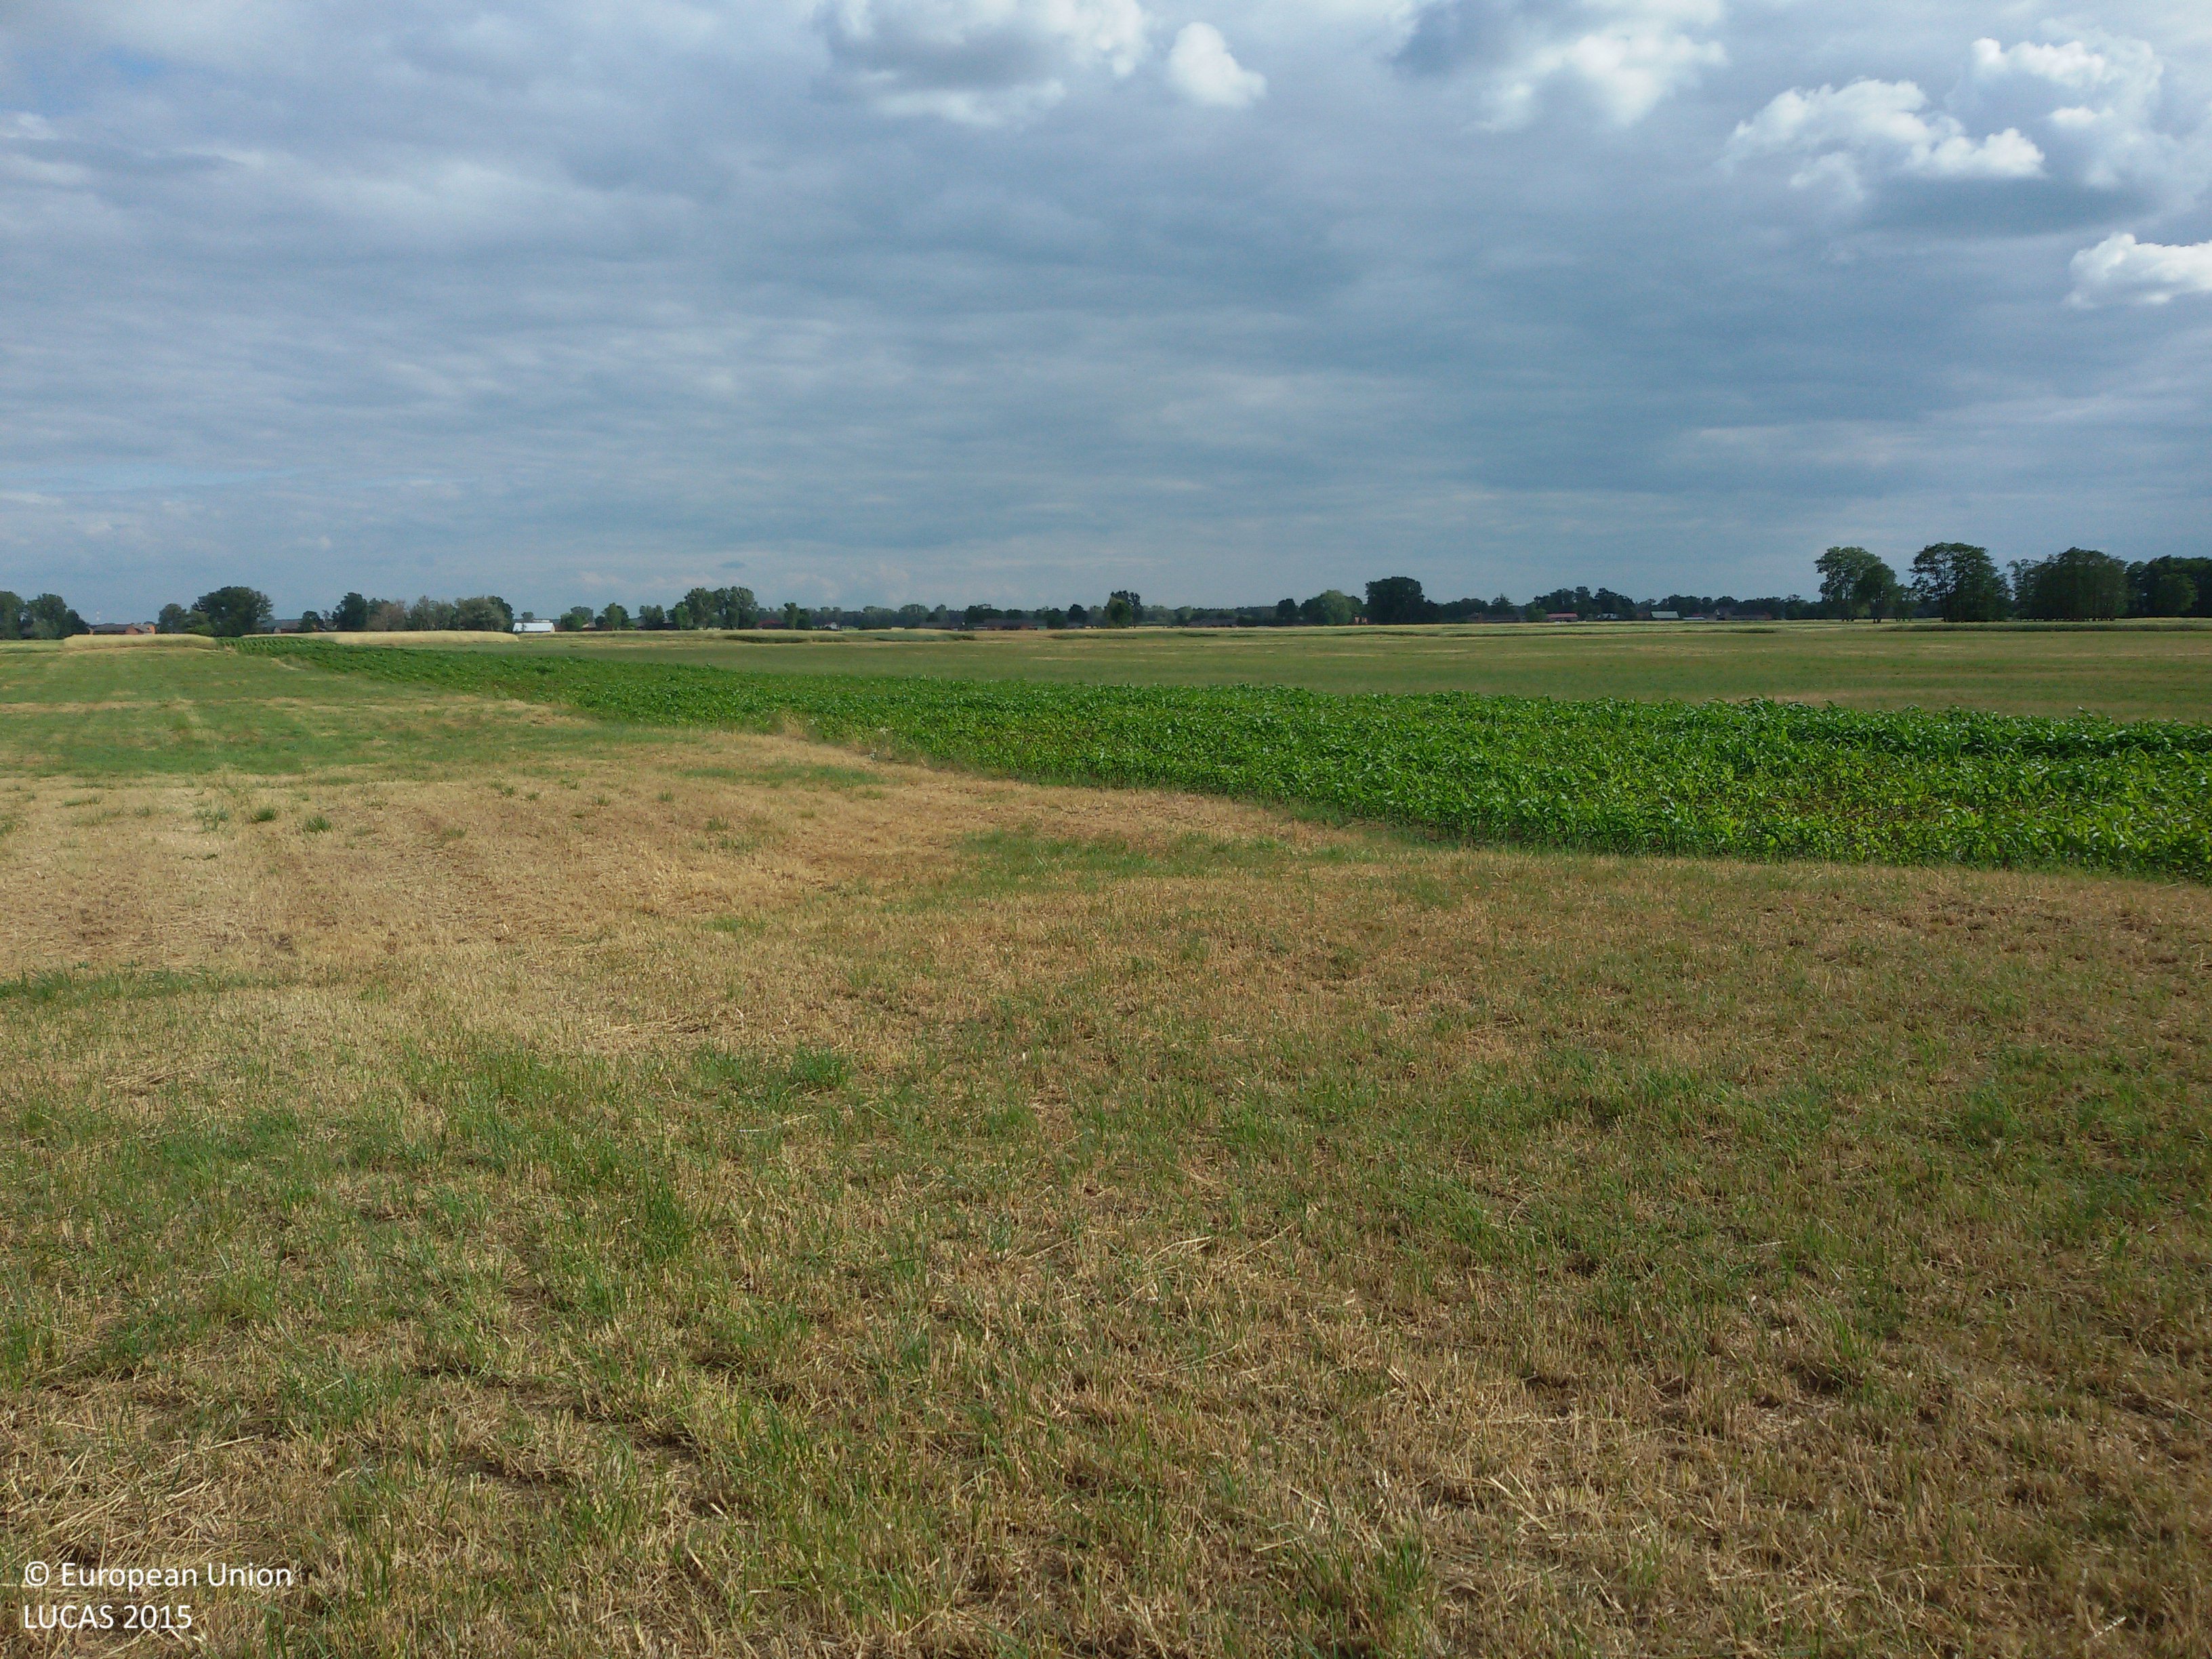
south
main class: Grassland
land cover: Grassland without tree/shrub cover
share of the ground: > 75 %
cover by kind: herbaceous plants 100 %
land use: Agriculture (excluding fallow land and kitchen gardens)
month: June
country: PL
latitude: 52.1159
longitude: 19.8005
